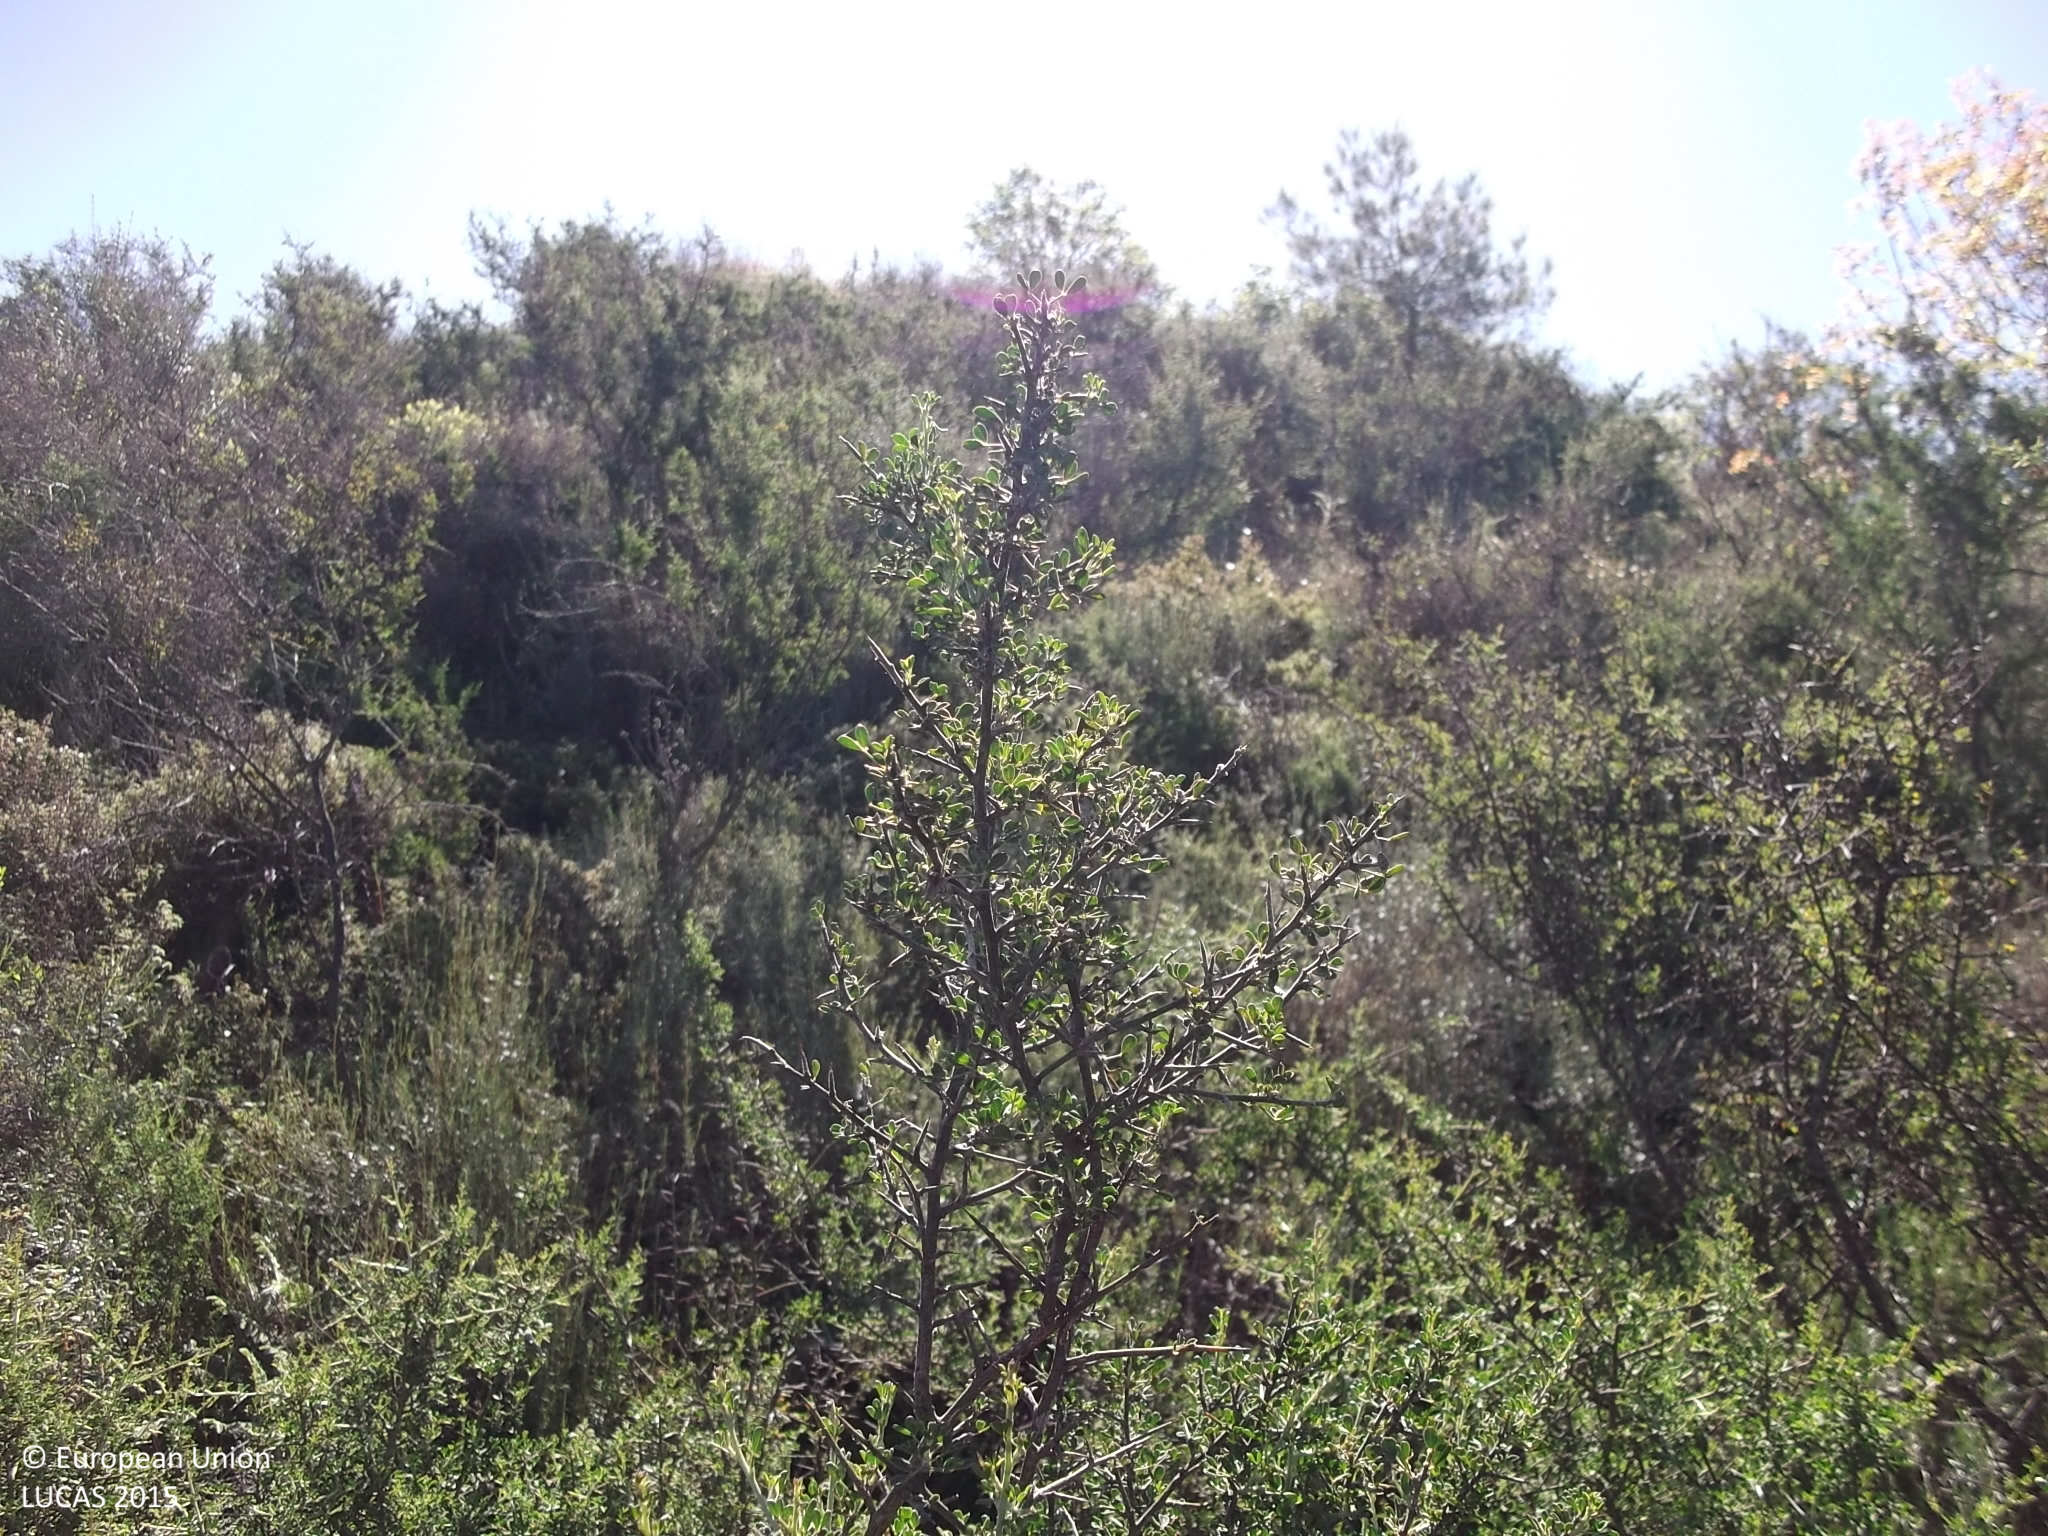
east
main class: Shrubland
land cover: Shrubland with sparse tree cover
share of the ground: > 75 %
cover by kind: shrubs 95 %, broadleaved forest trees 5 %
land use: Semi-natural and natural areas not in use
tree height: < 5 m
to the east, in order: Shrubland with sparse tree cover; Other fresh vegetables; Tracks; Shrubland with sparse tree cover; Shrubland without tree cover; Spontaneously vegetated surfaces; Shrubland with sparse tree cover; Shrubland without tree cover
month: April
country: CY
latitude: 34.8259
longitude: 33.1681
